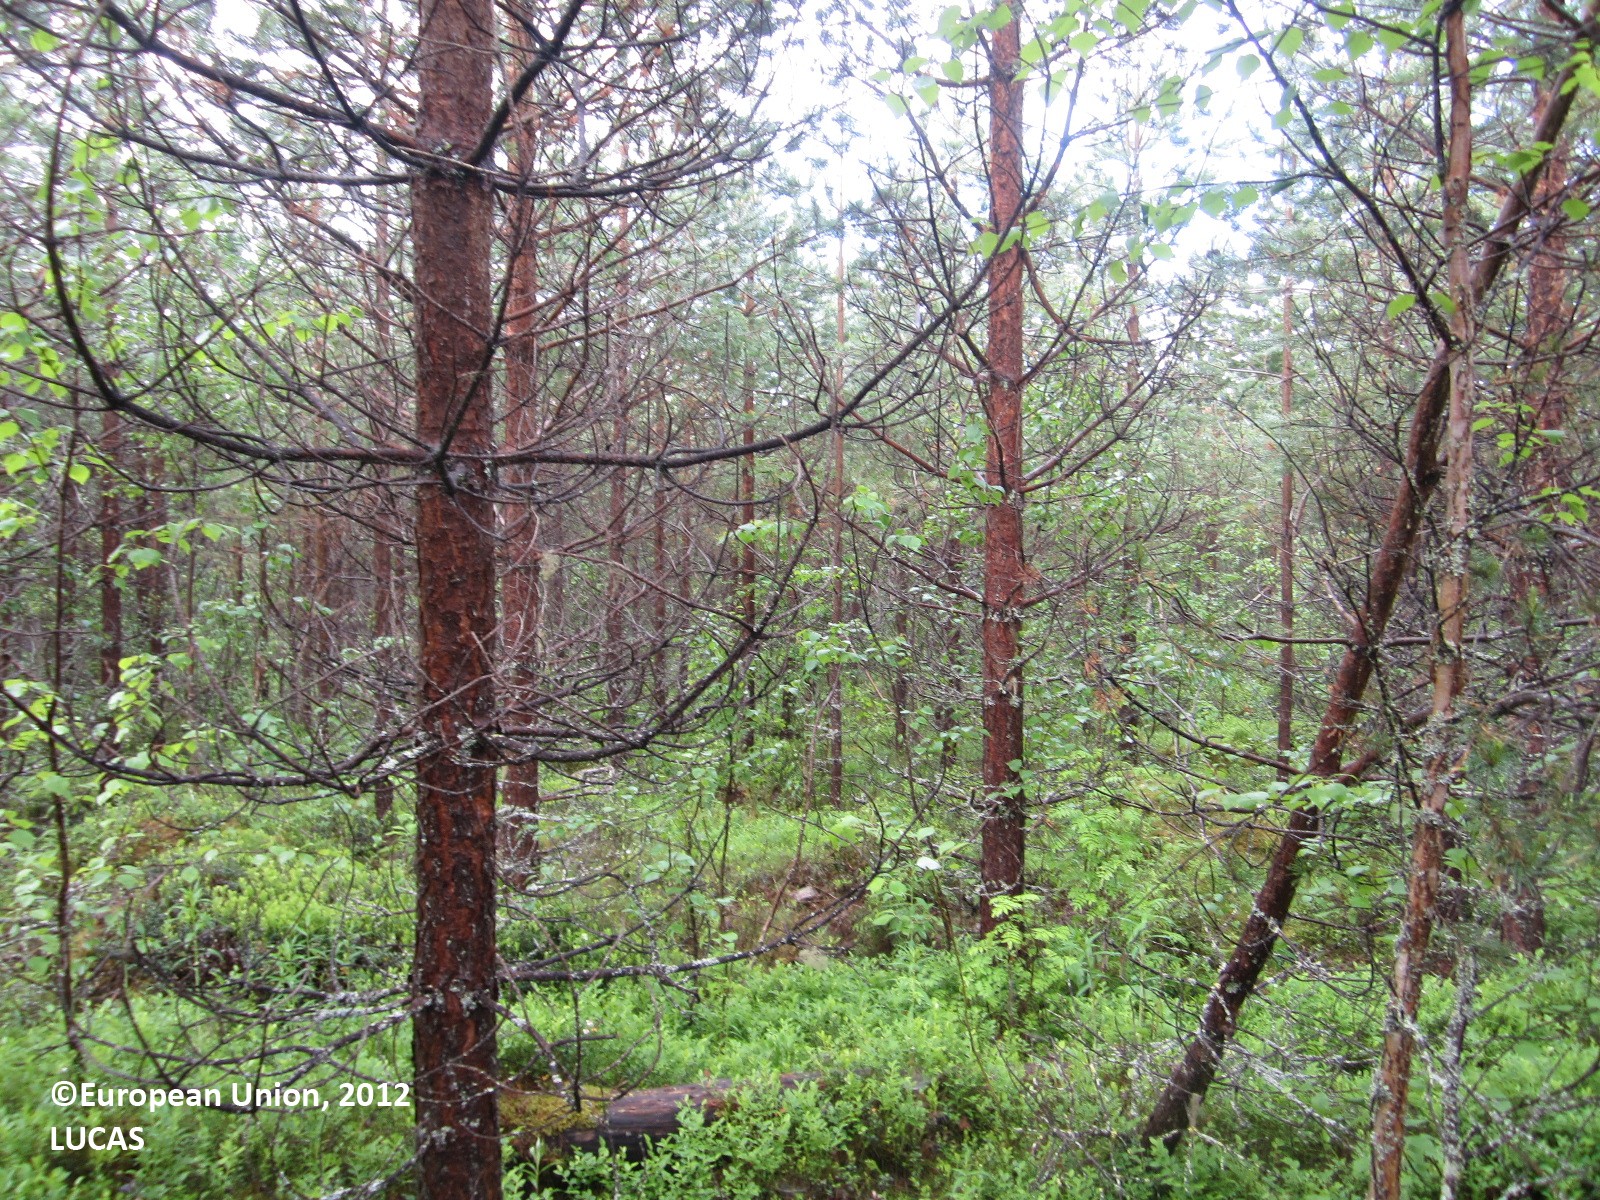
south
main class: Woodland
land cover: Pine dominated coniferous woodland
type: boreal forest
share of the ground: > 75 %
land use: Forestry
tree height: > 5 m
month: June
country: FI
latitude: 64.5097
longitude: 29.5630
